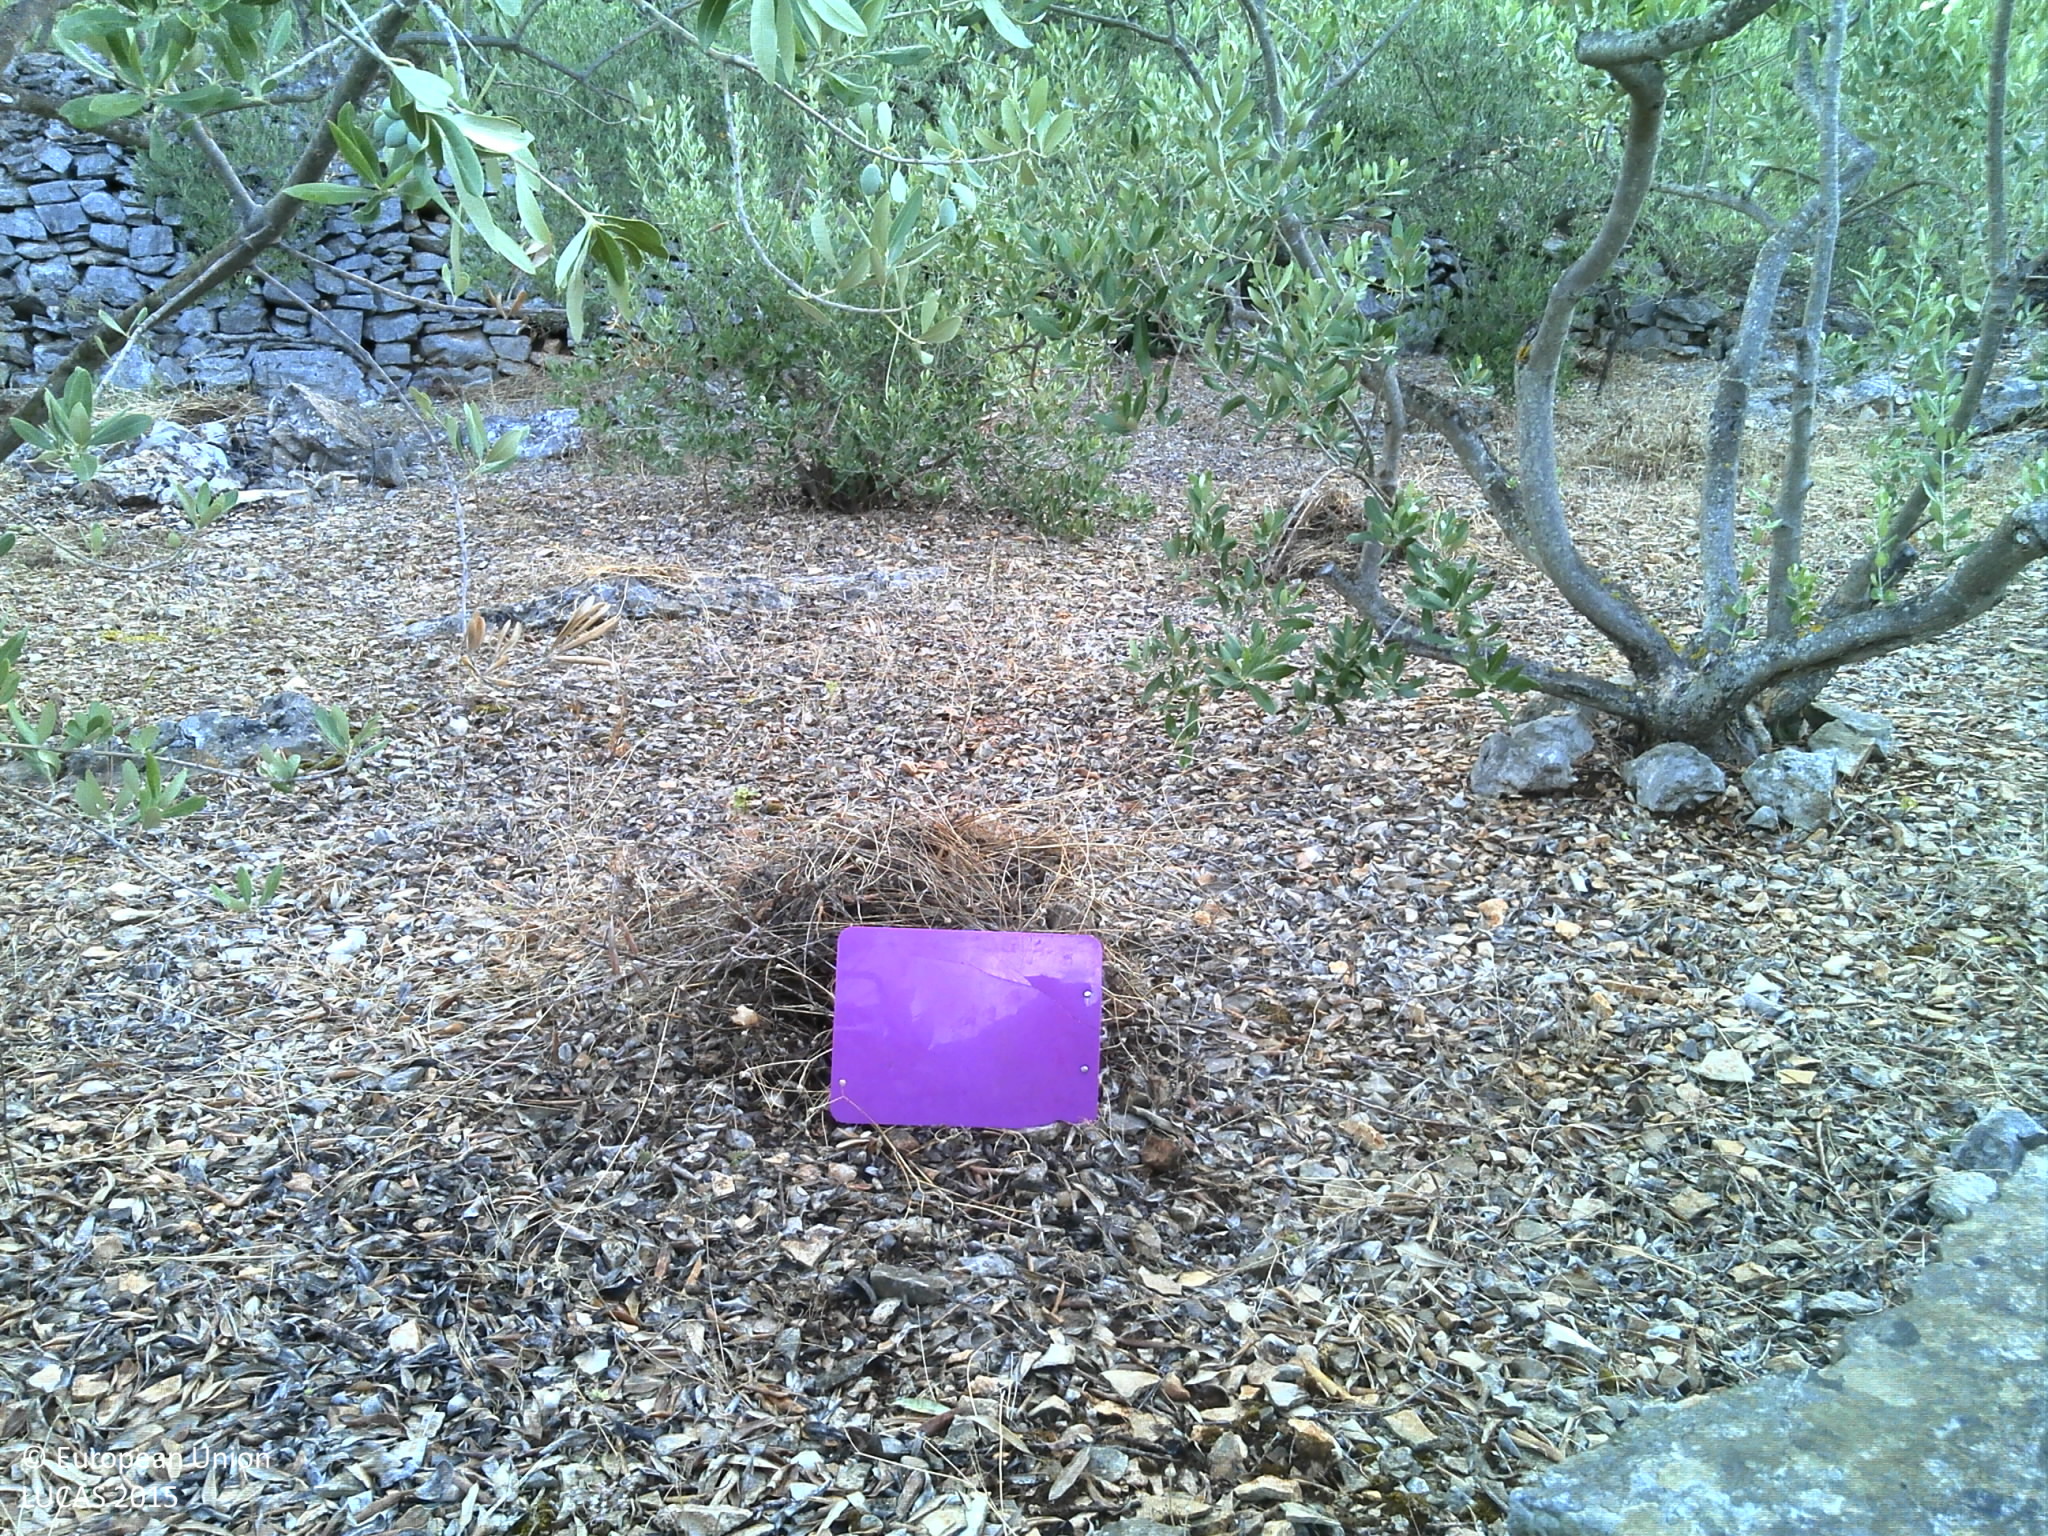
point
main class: Cropland
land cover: Olive groves
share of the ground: 50 - 75 %
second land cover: Other bare soil
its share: > 75 %
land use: Agriculture (excluding fallow land and kitchen gardens)
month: August
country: HR
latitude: 43.4008
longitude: 16.2749
